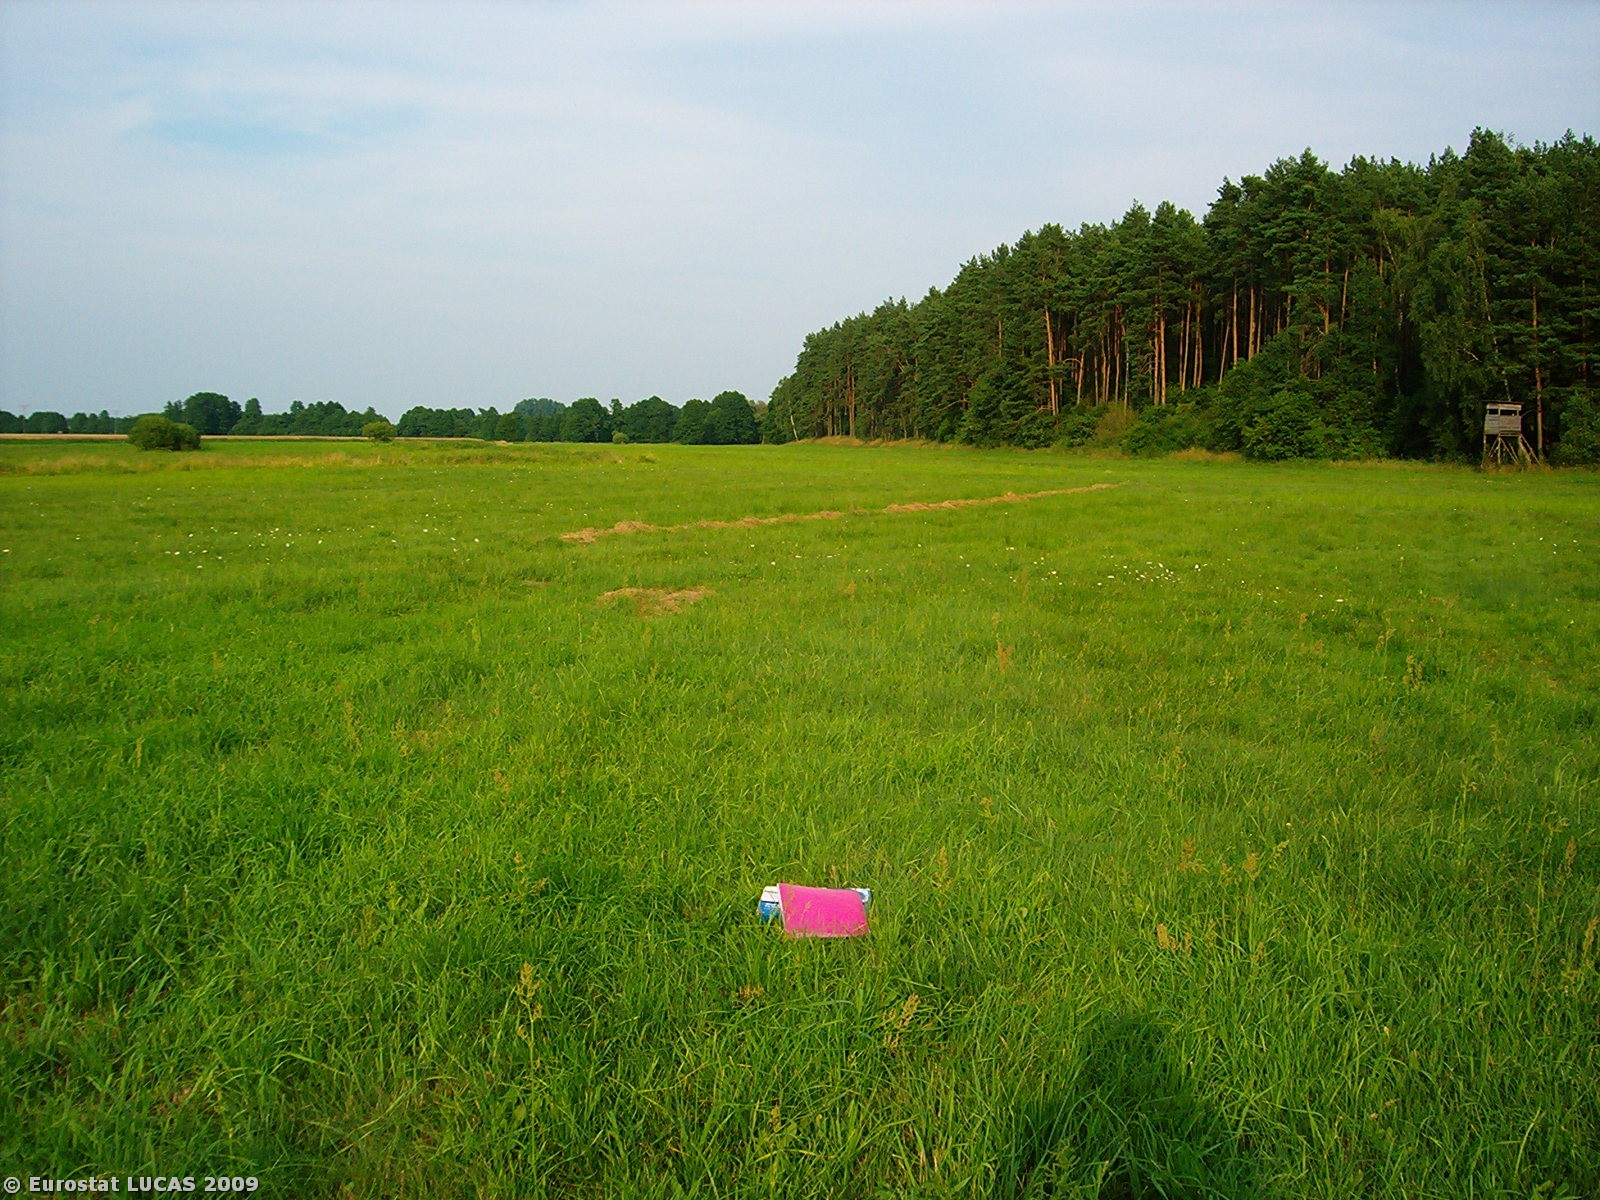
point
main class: Grassland
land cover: Grassland without tree/shrub cover
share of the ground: > 75 %
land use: Agriculture (excluding fallow land and kitchen gardens)
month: July
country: PL
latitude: 52.6166
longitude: 15.7501
